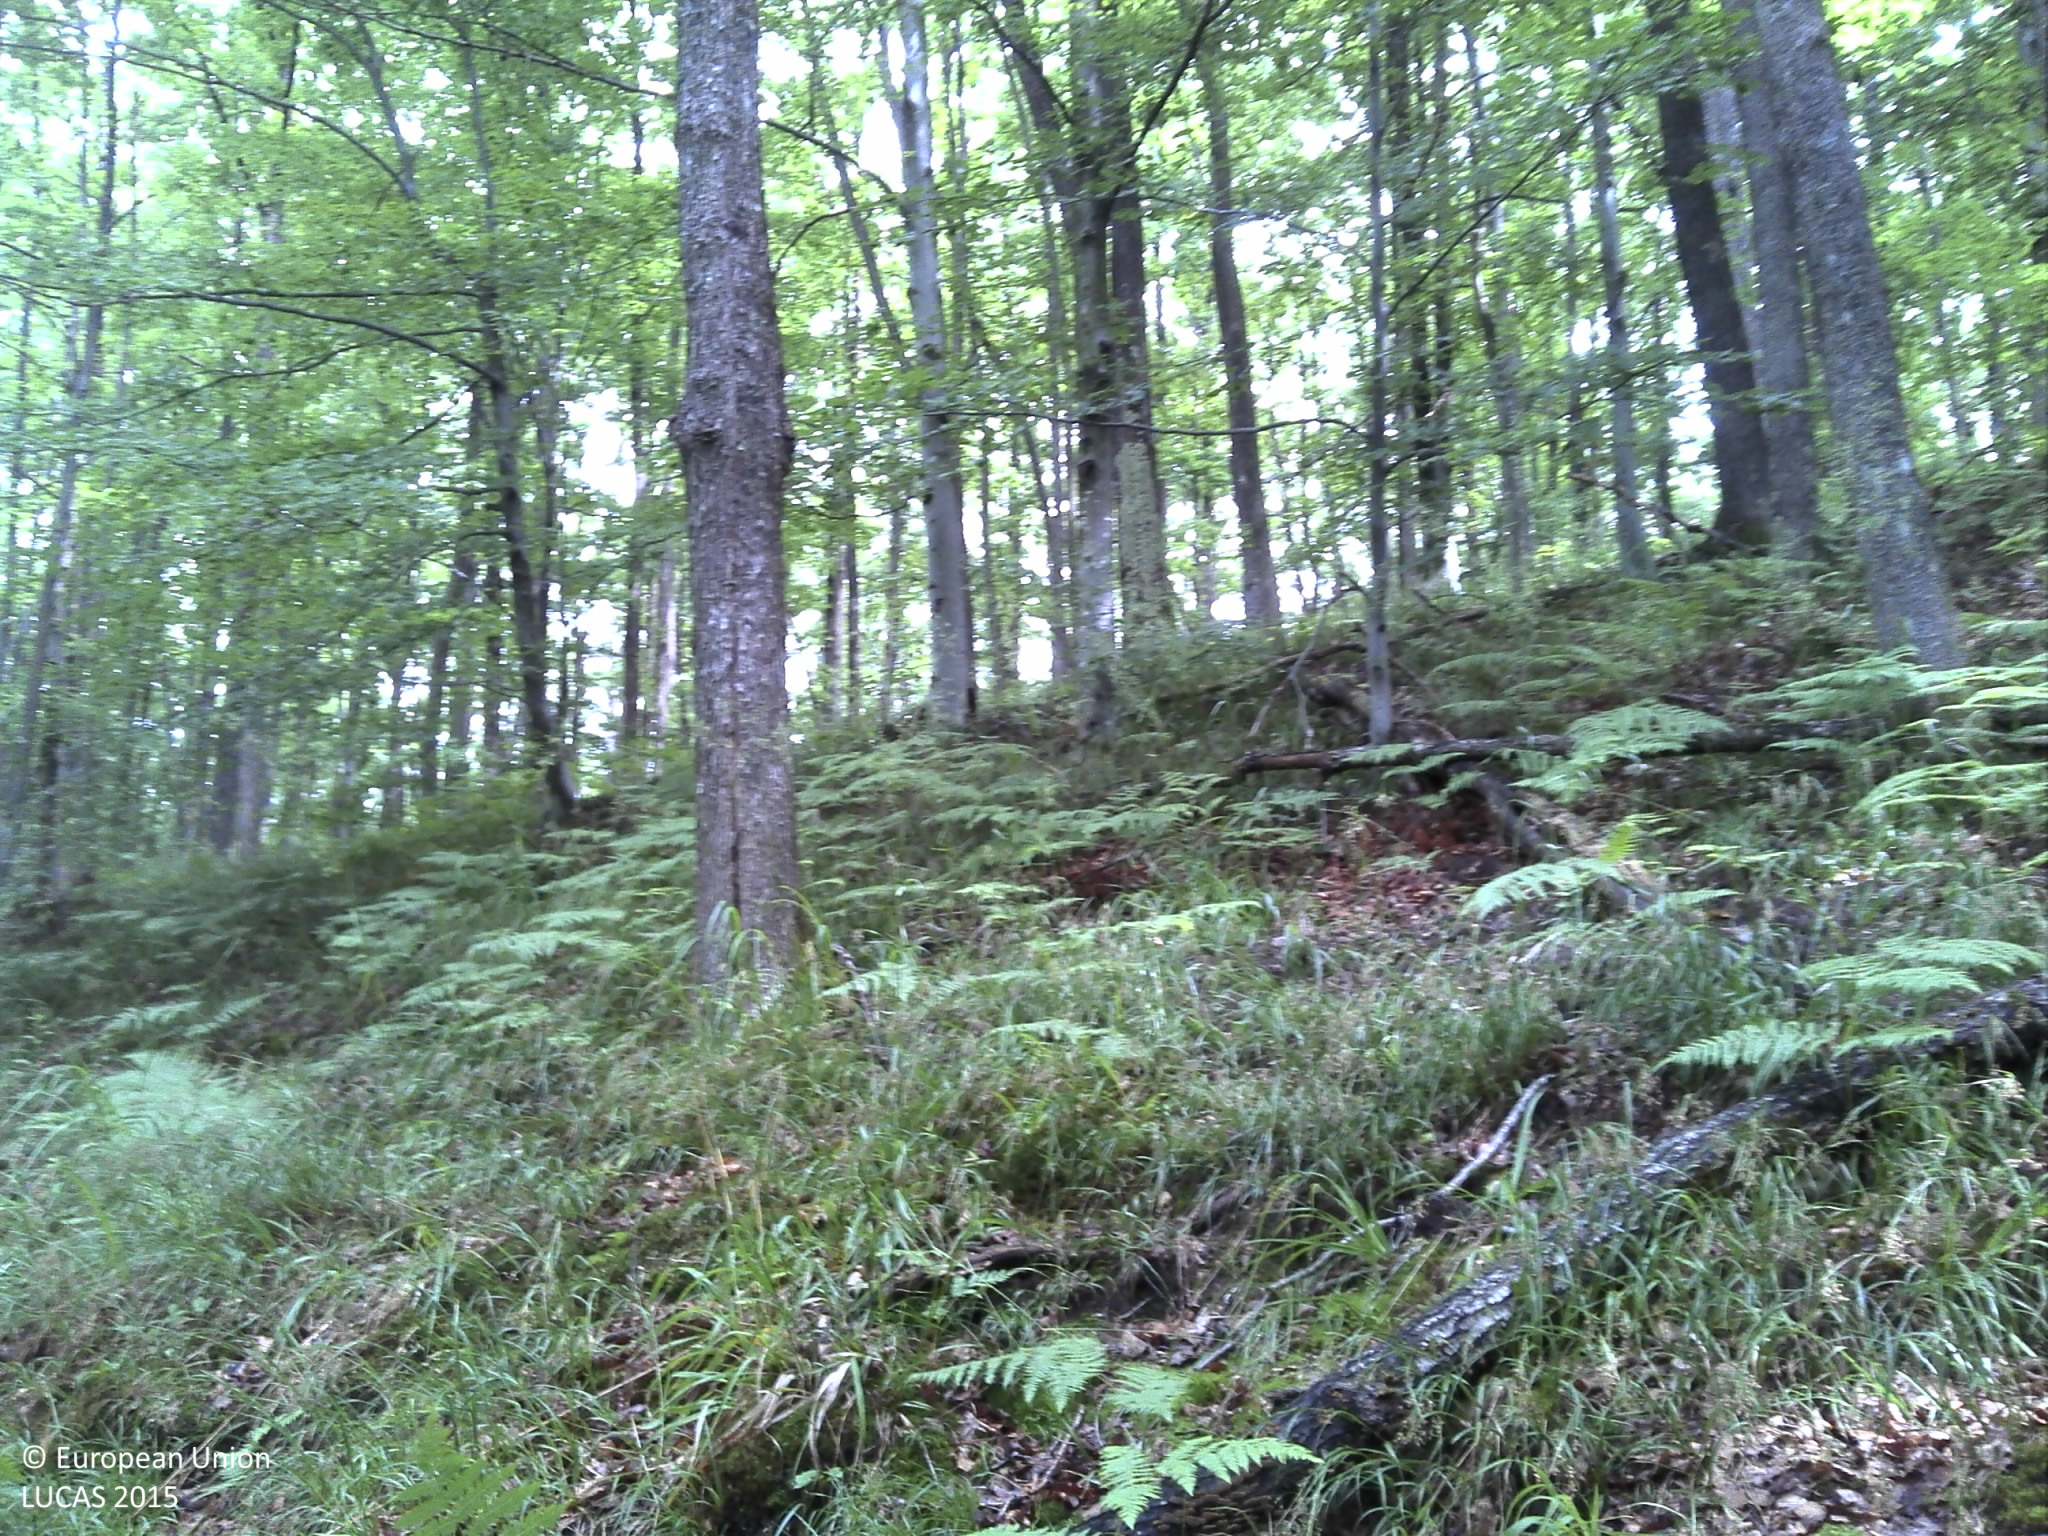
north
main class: Woodland
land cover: Broadleaved woodland
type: beech forest
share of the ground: > 75 %
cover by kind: broadleaved forest trees 80 %, lichens and mosses 20 %
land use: Forestry
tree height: > 5 m
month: June
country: HR
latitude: 45.5275
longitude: 17.4918
